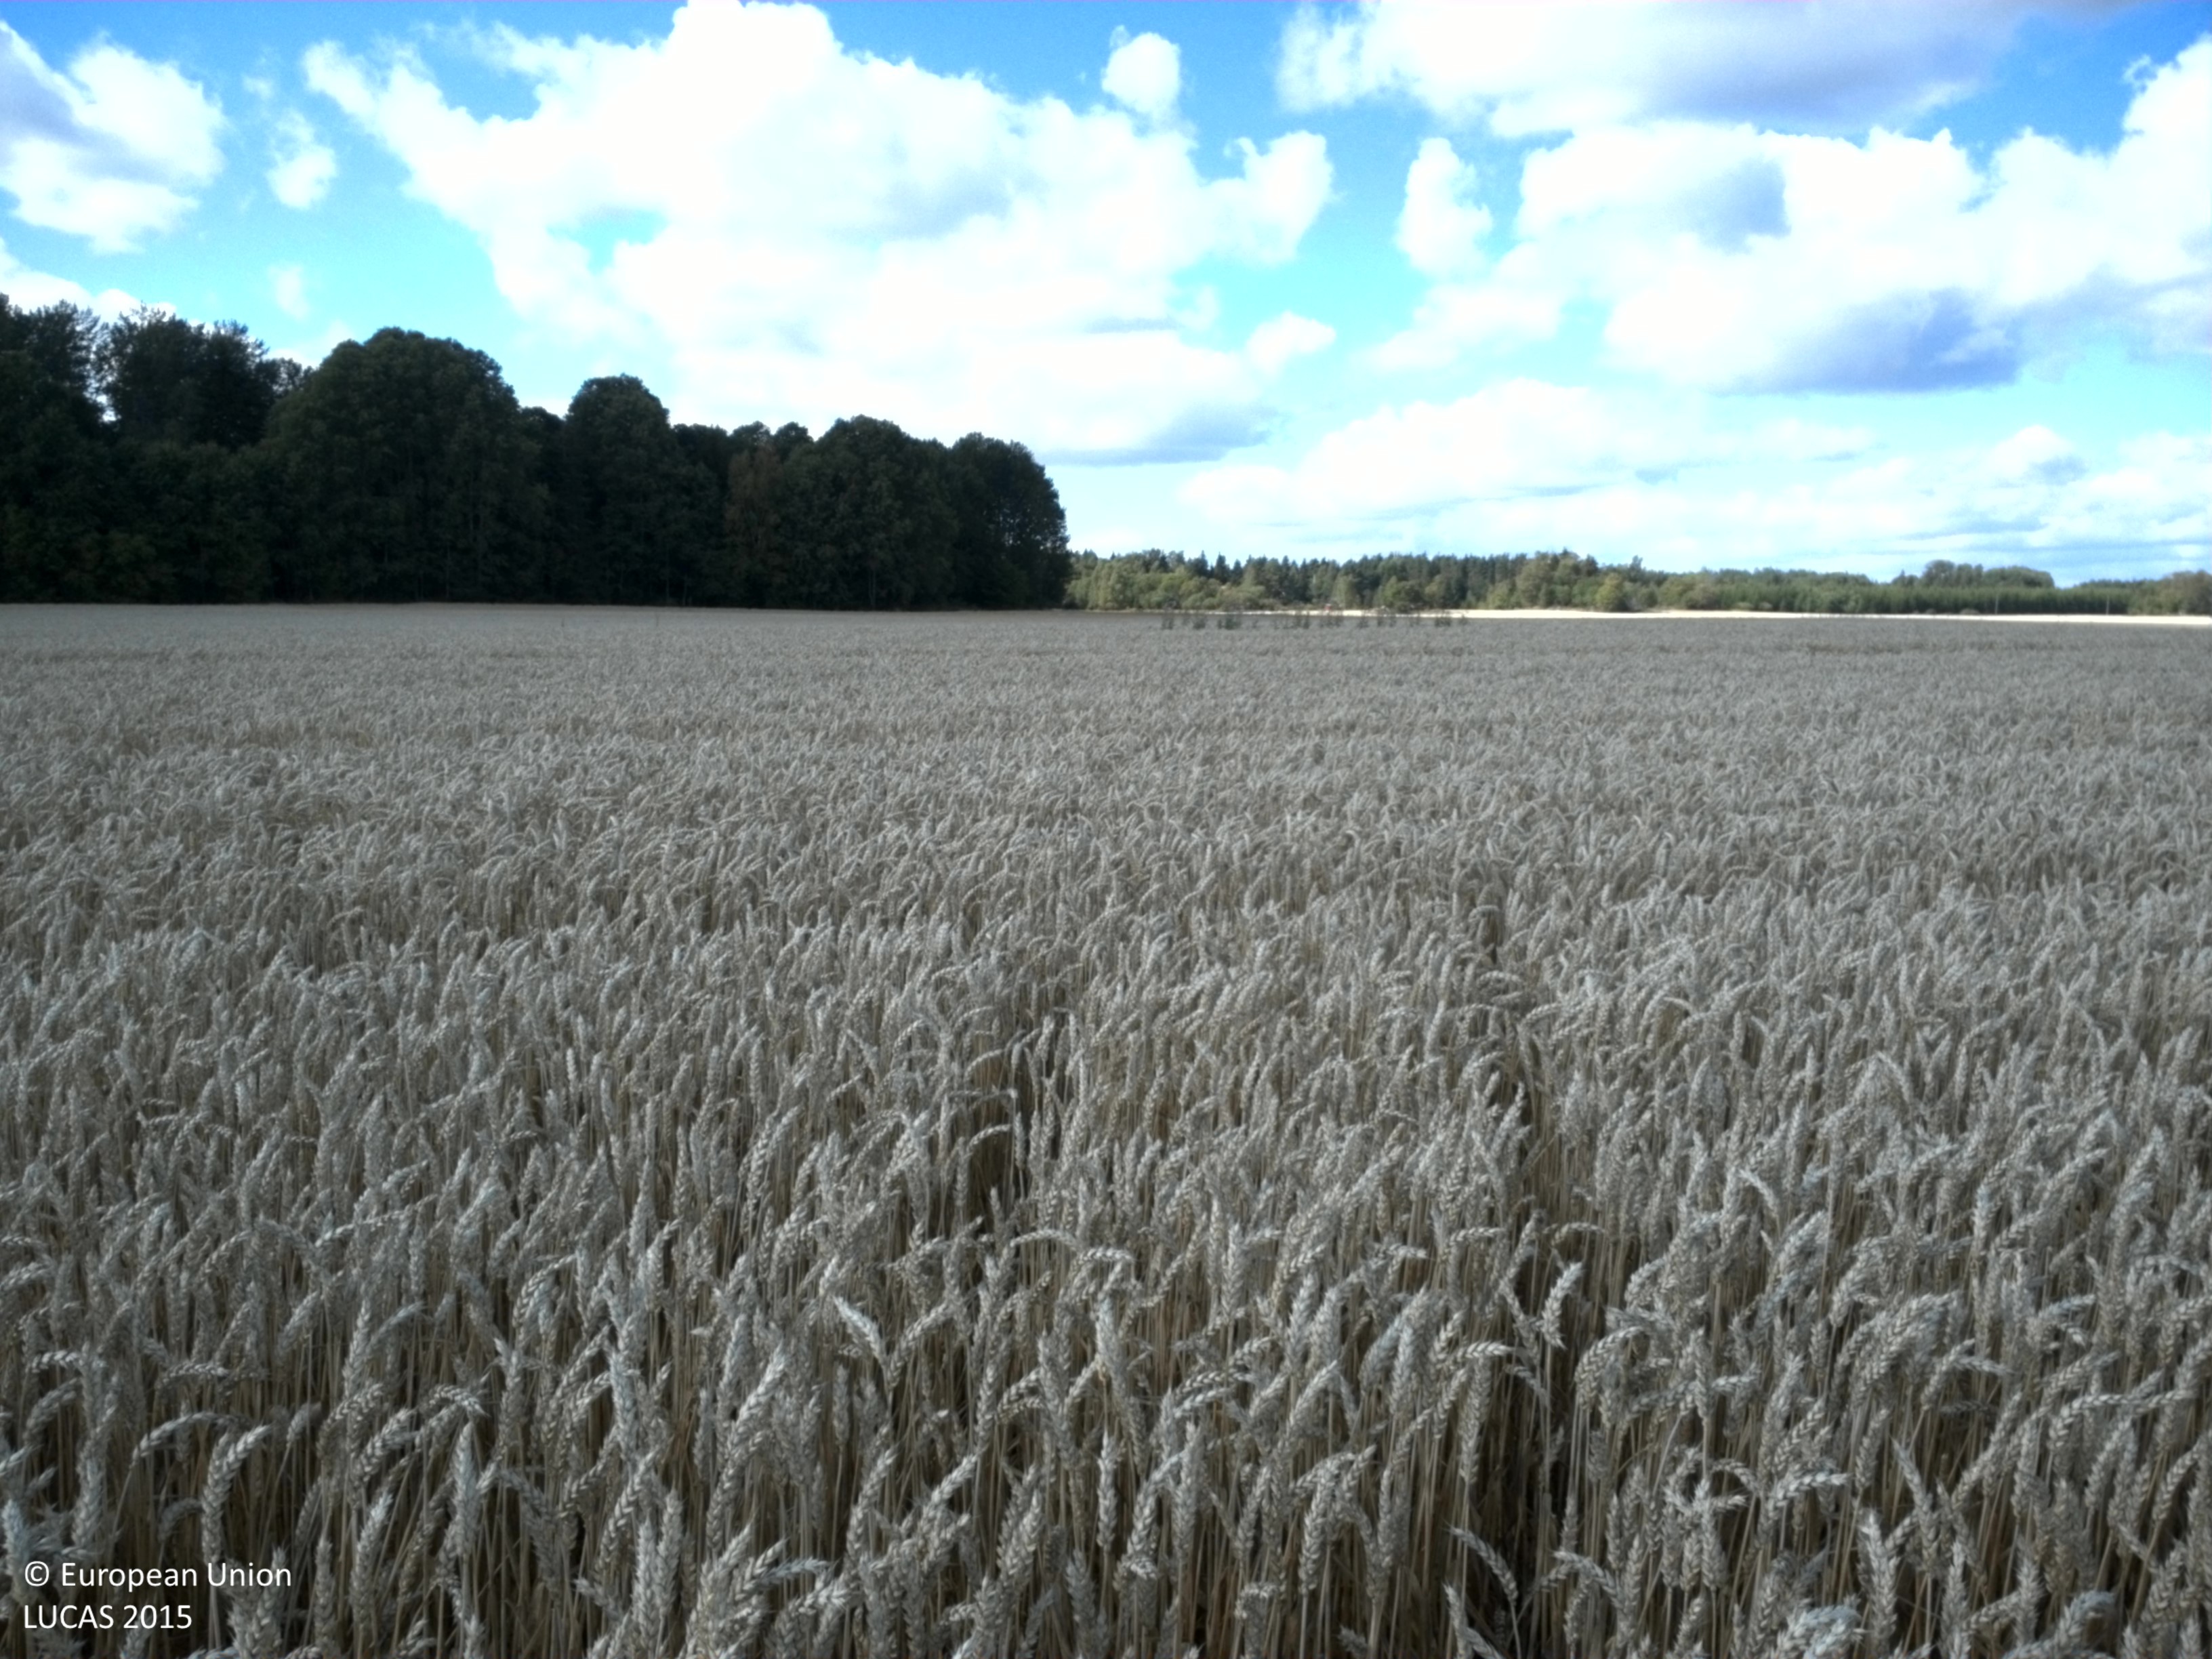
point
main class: Cropland
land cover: Common wheat
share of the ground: > 75 %
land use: Agriculture (excluding fallow land and kitchen gardens)
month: August
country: SE
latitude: 59.7042
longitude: 16.9059
